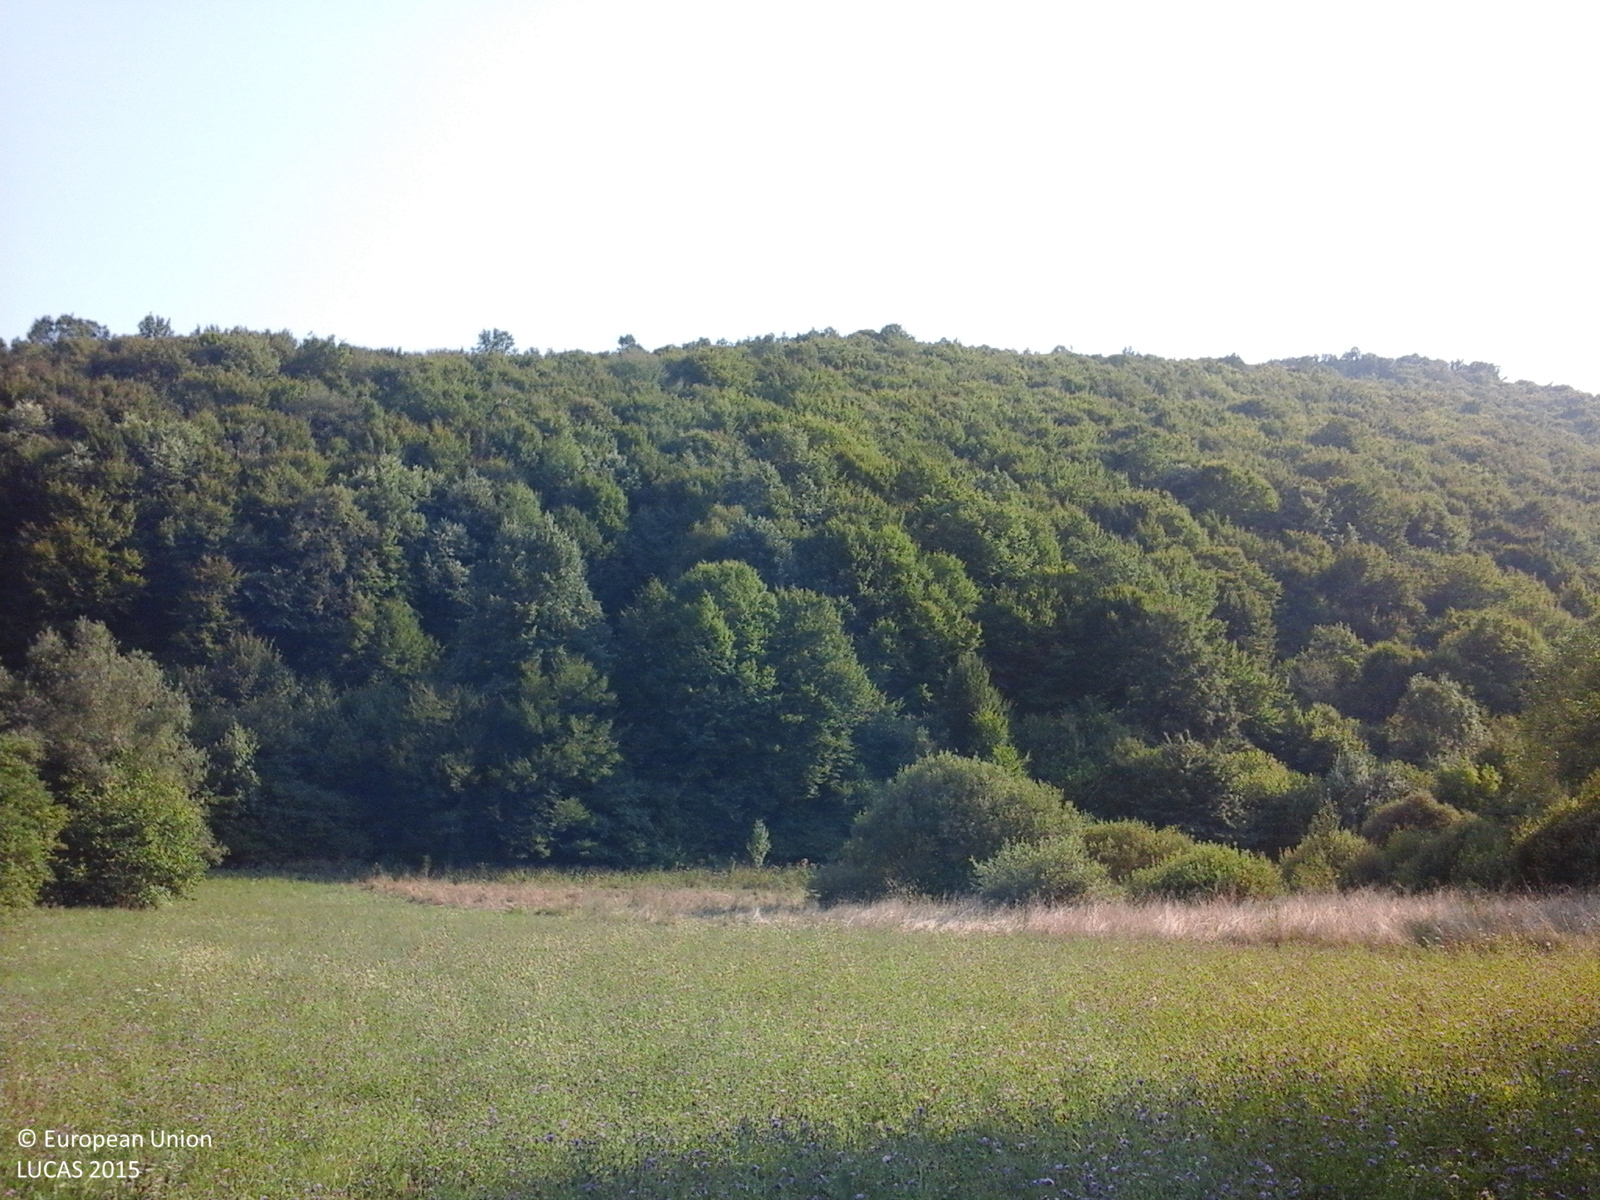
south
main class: Cropland
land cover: Other leguminous and mixtures for fodder
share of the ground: > 75 %
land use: Agriculture (excluding fallow land and kitchen gardens)
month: August
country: RO
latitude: 46.0851
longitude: 22.0568
